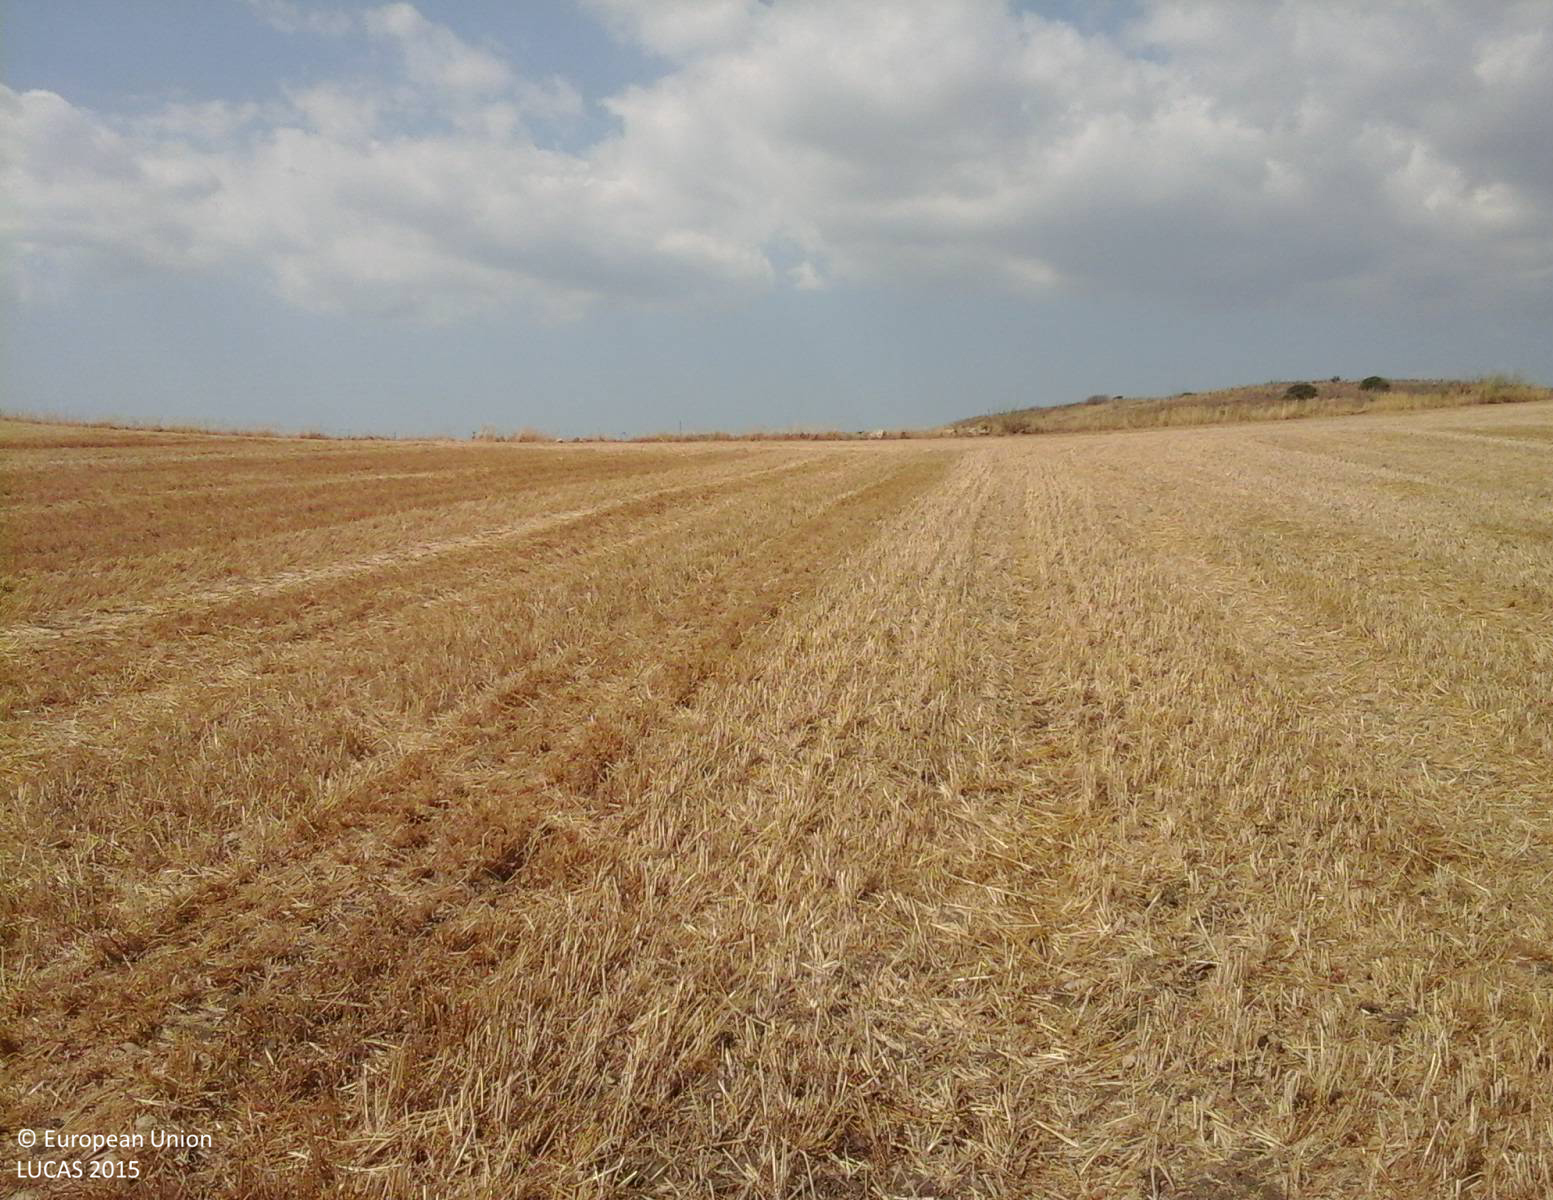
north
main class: Cropland
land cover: Barley
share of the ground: < 10 %
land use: Agriculture (excluding fallow land and kitchen gardens)
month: July
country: IT
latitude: 39.7168
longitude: 8.8053
